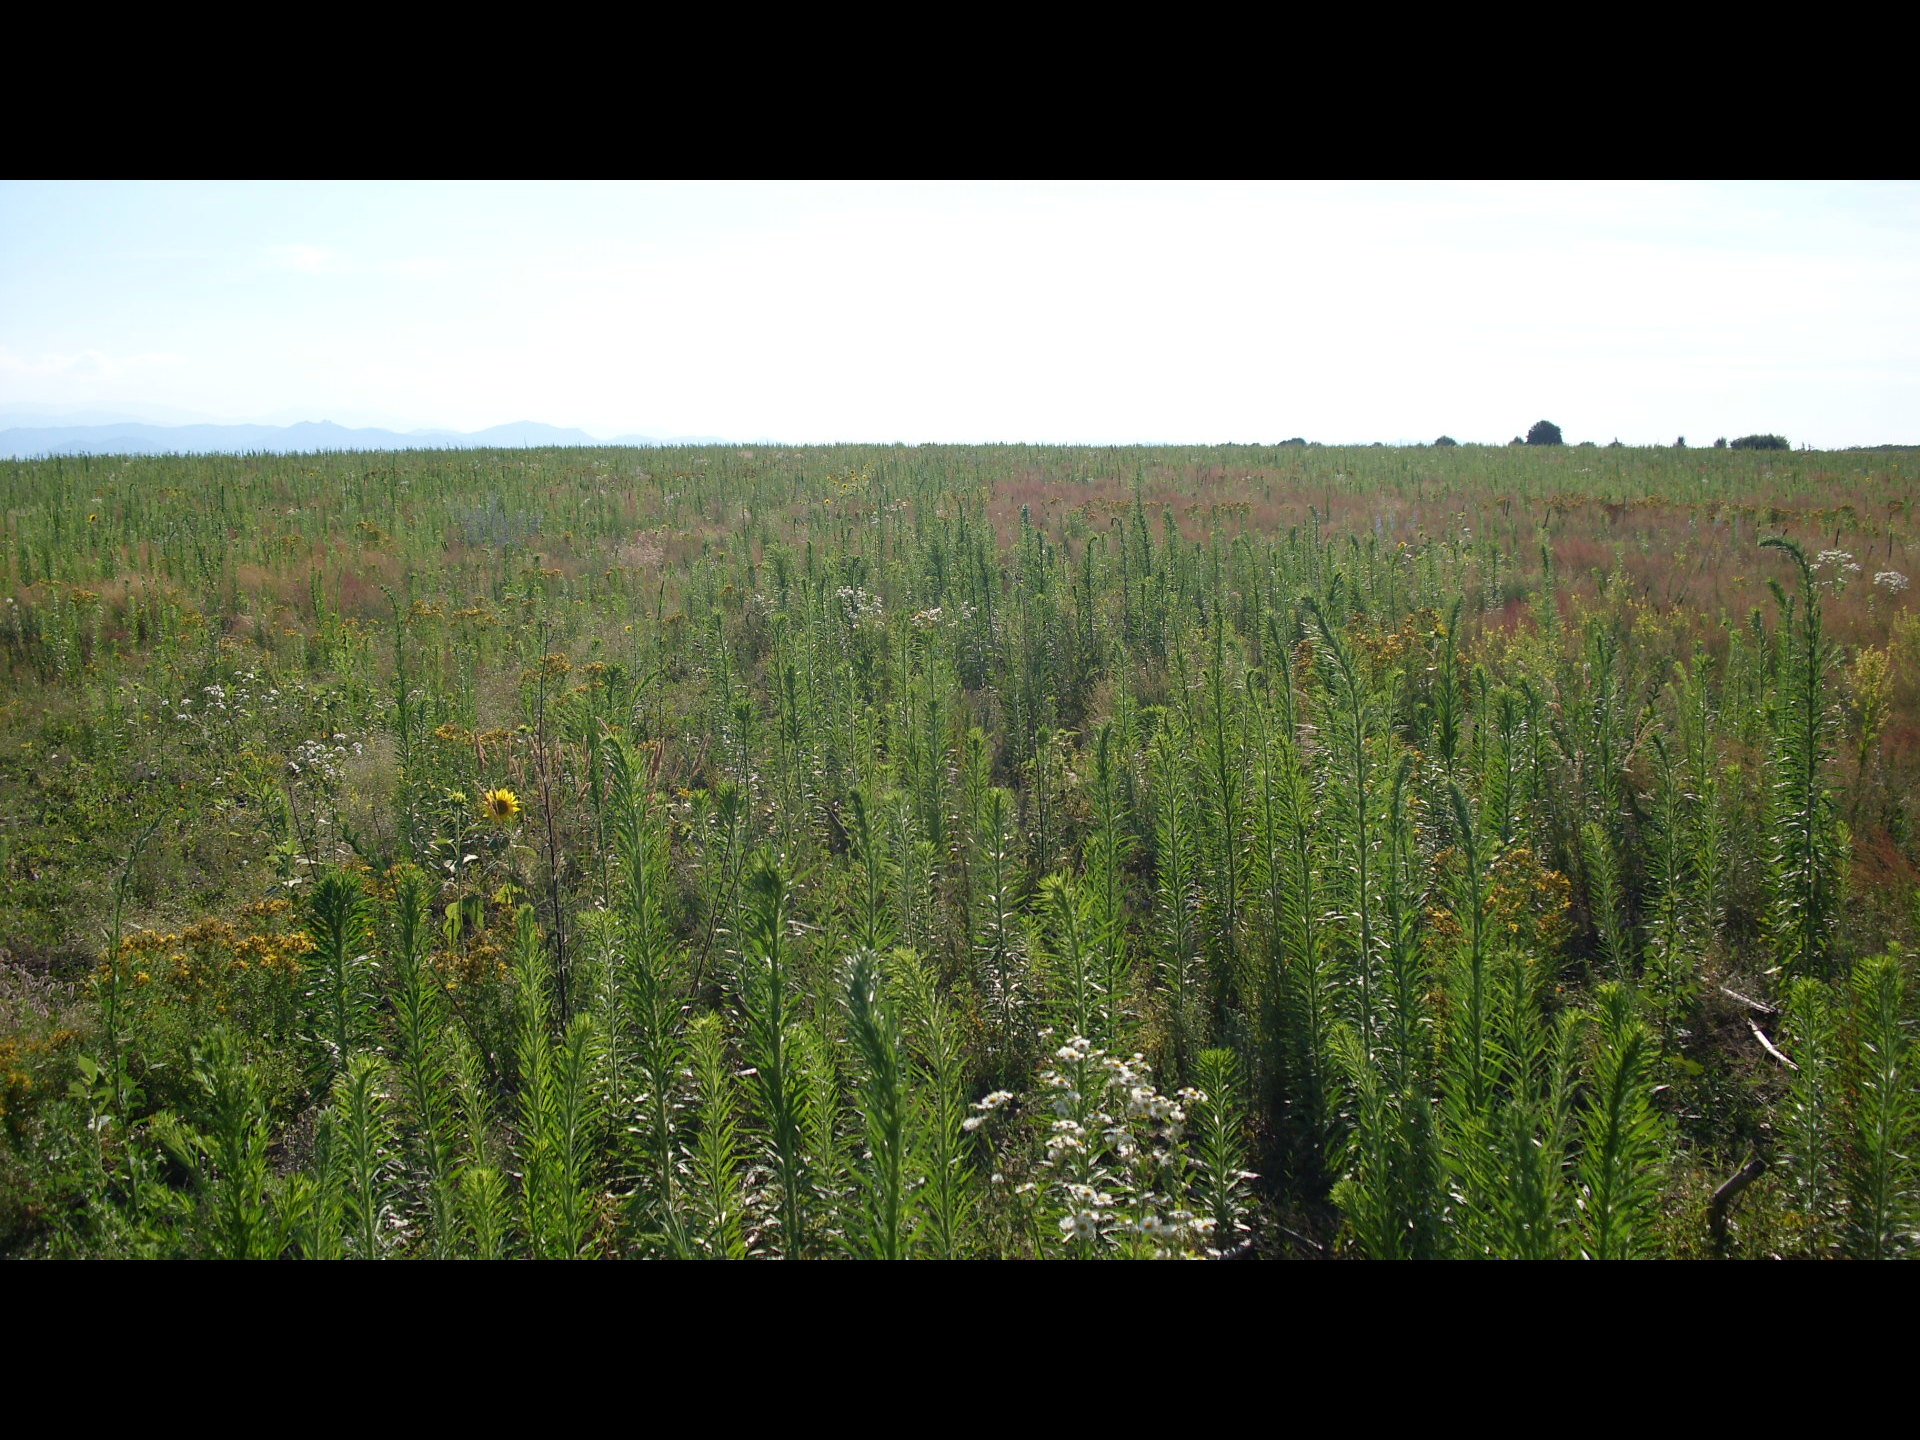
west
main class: Grassland
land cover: Spontaneously vegetated surfaces
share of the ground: > 75 %
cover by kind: herbaceous plants 85 %, unconsolidated bare surface 15 %
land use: Fallow land
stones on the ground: < 10 %
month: June
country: BG
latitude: 43.5642
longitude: 23.1510
